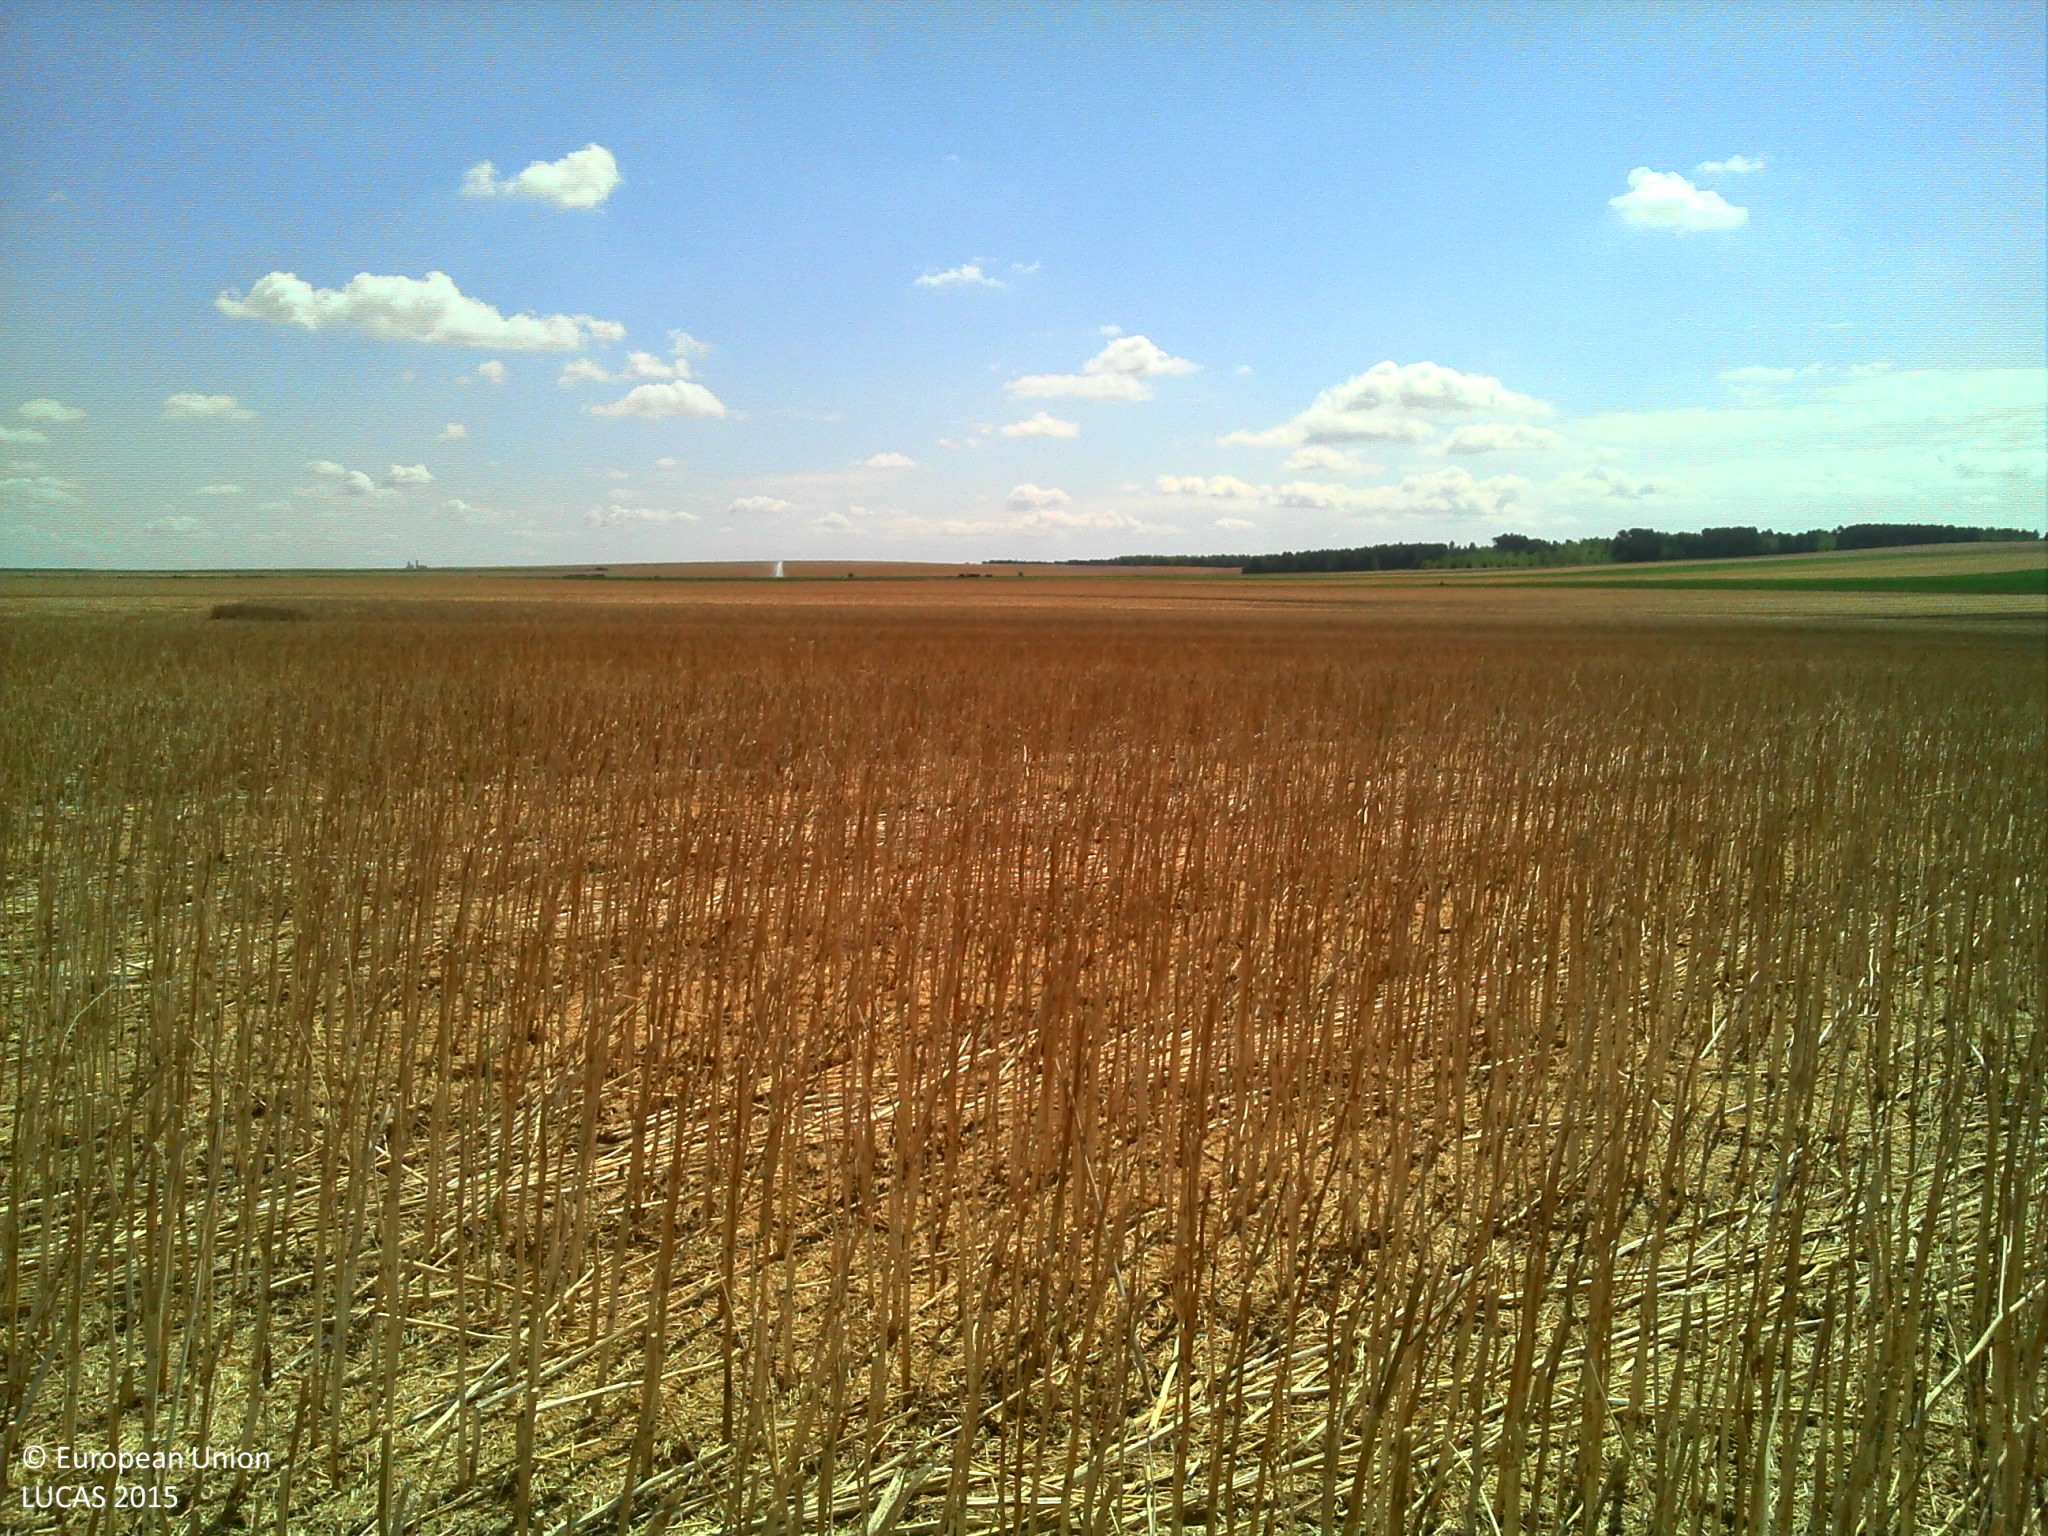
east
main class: Cropland
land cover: Rape and turnip rape
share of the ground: > 75 %
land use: Agriculture (excluding fallow land and kitchen gardens)
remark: Harvested field
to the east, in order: Rape and turnip rape; Grass margins; Tracks; Grass margins; Common wheat
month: July
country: FR
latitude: 49.3377
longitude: 4.2843
